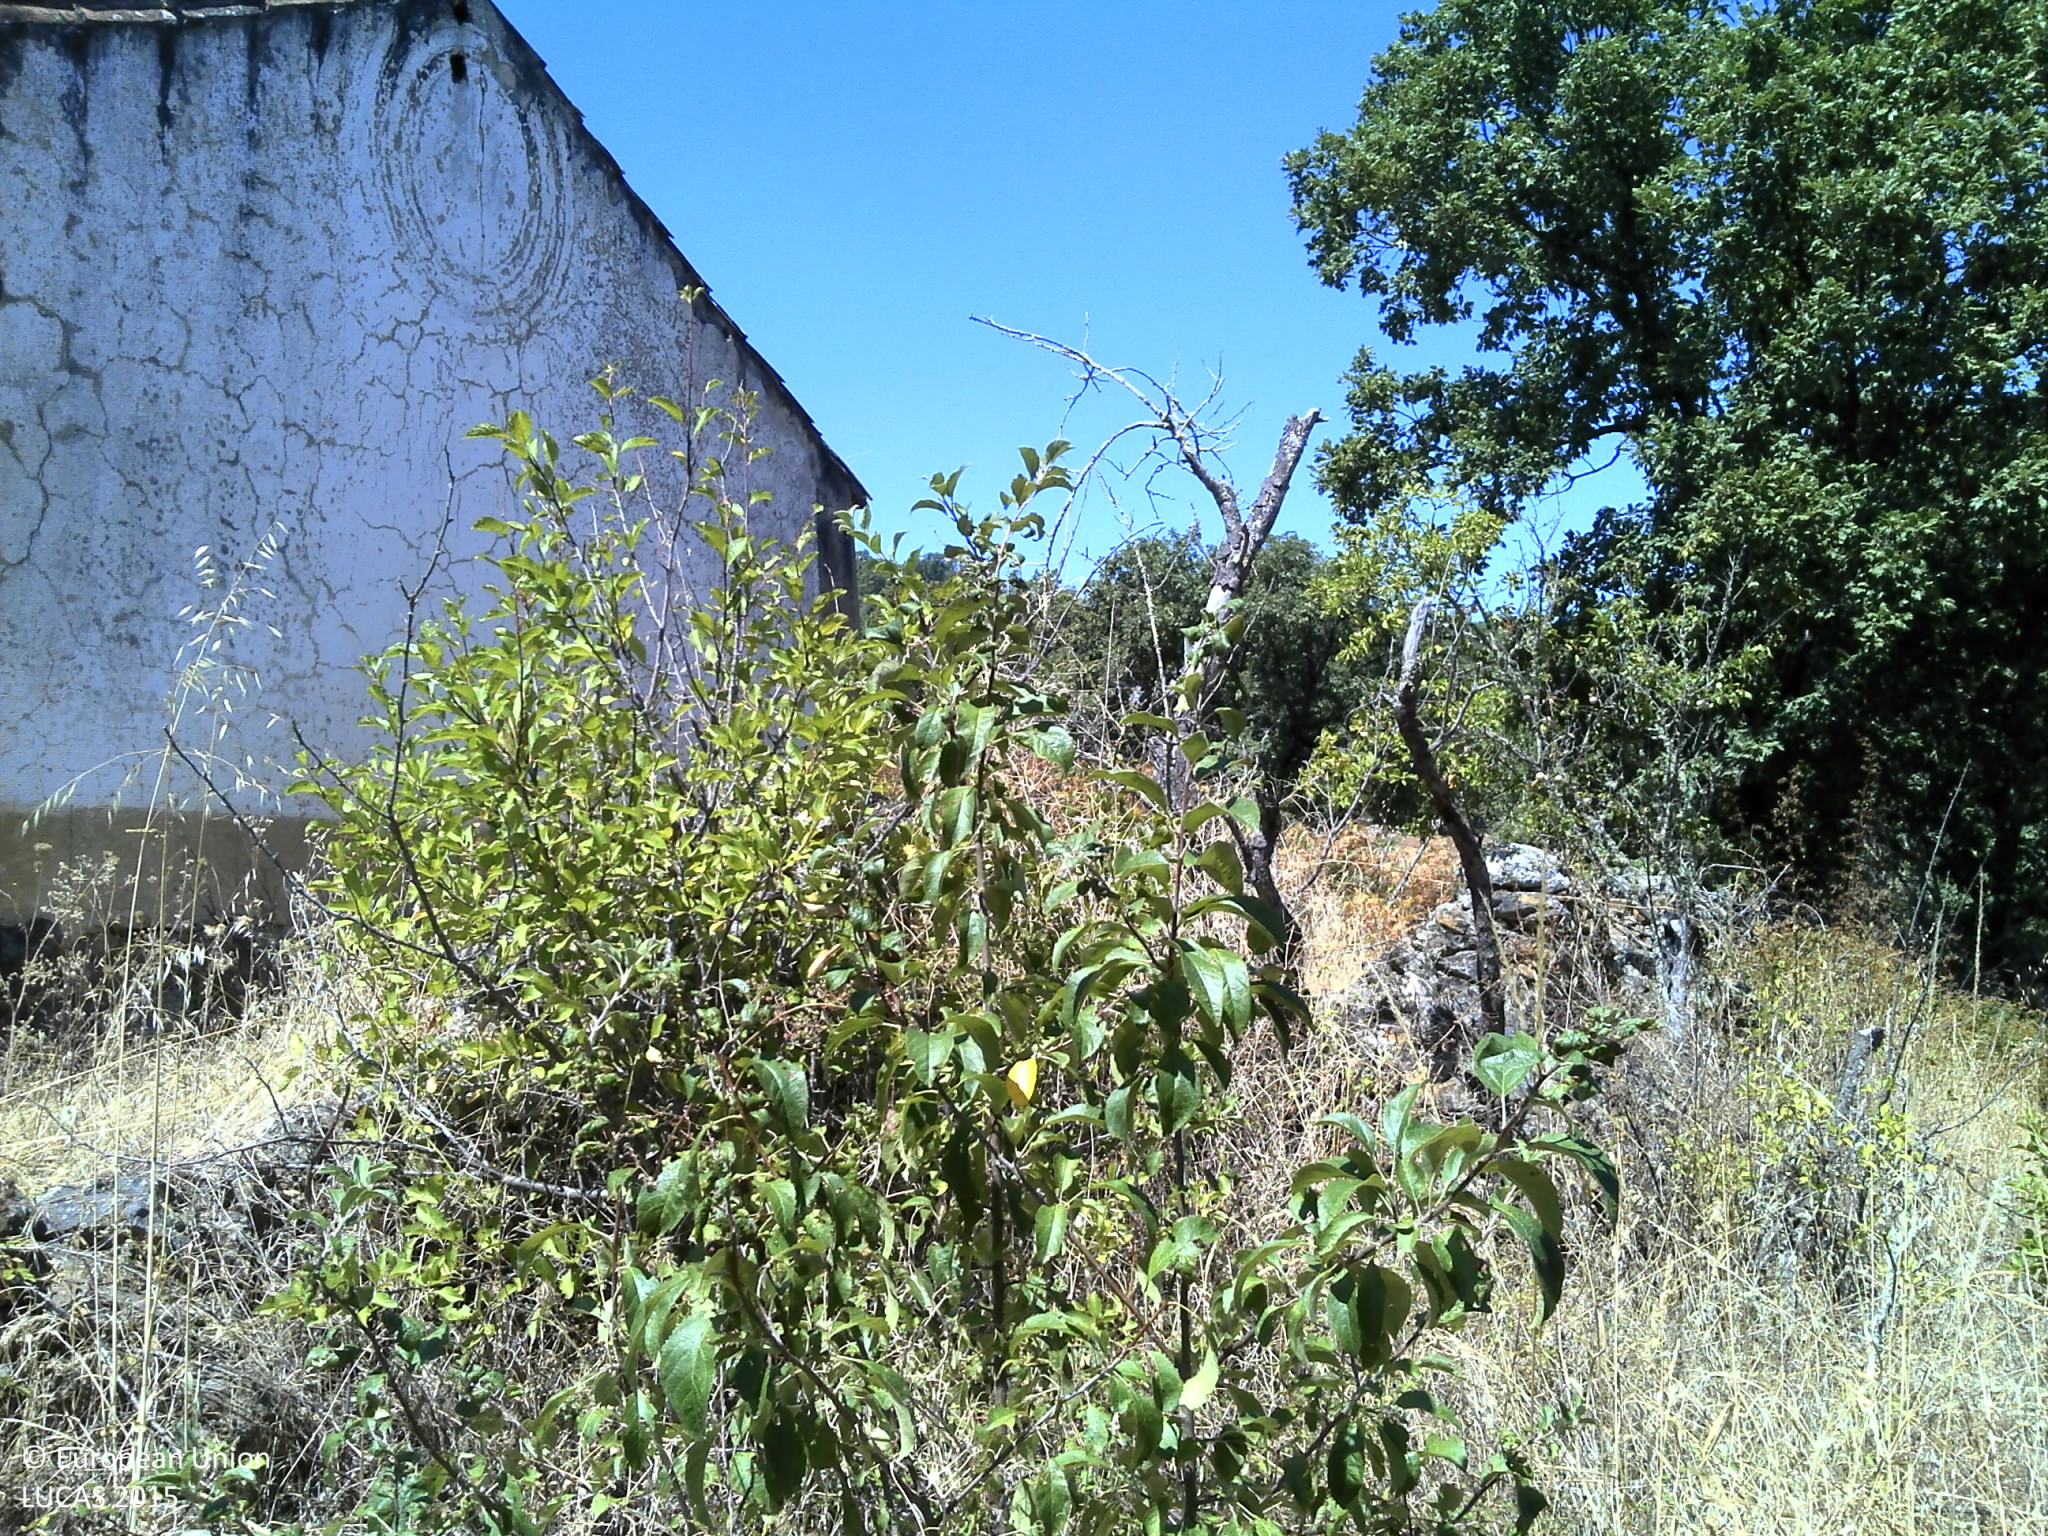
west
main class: Cropland
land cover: Apple fruit
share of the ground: 10 - 25 %
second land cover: Other bare soil
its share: > 75 %
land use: Agriculture (excluding fallow land and kitchen gardens)
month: August
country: PT
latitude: 39.3646
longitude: -7.3936
